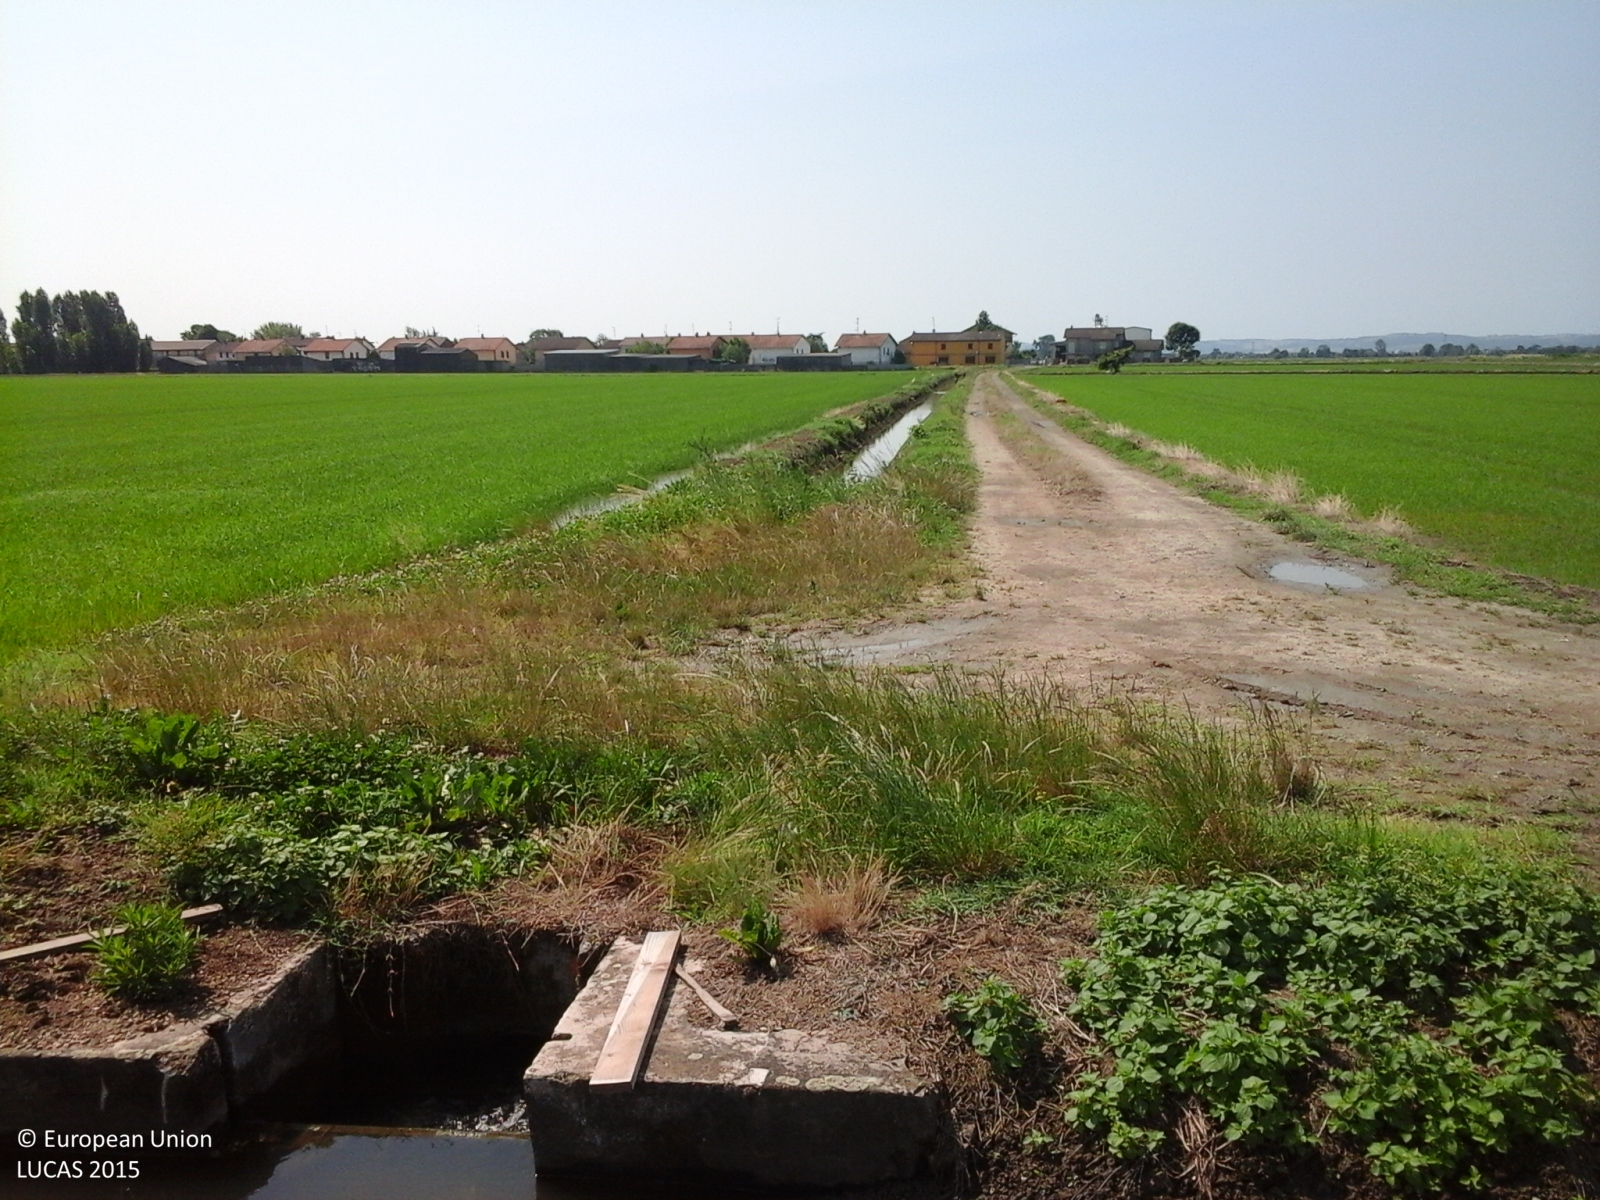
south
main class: Cropland
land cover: Rice
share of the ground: 25 - 50 %
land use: Agriculture (excluding fallow land and kitchen gardens)
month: July
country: IT
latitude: 45.2401
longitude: 8.4104
